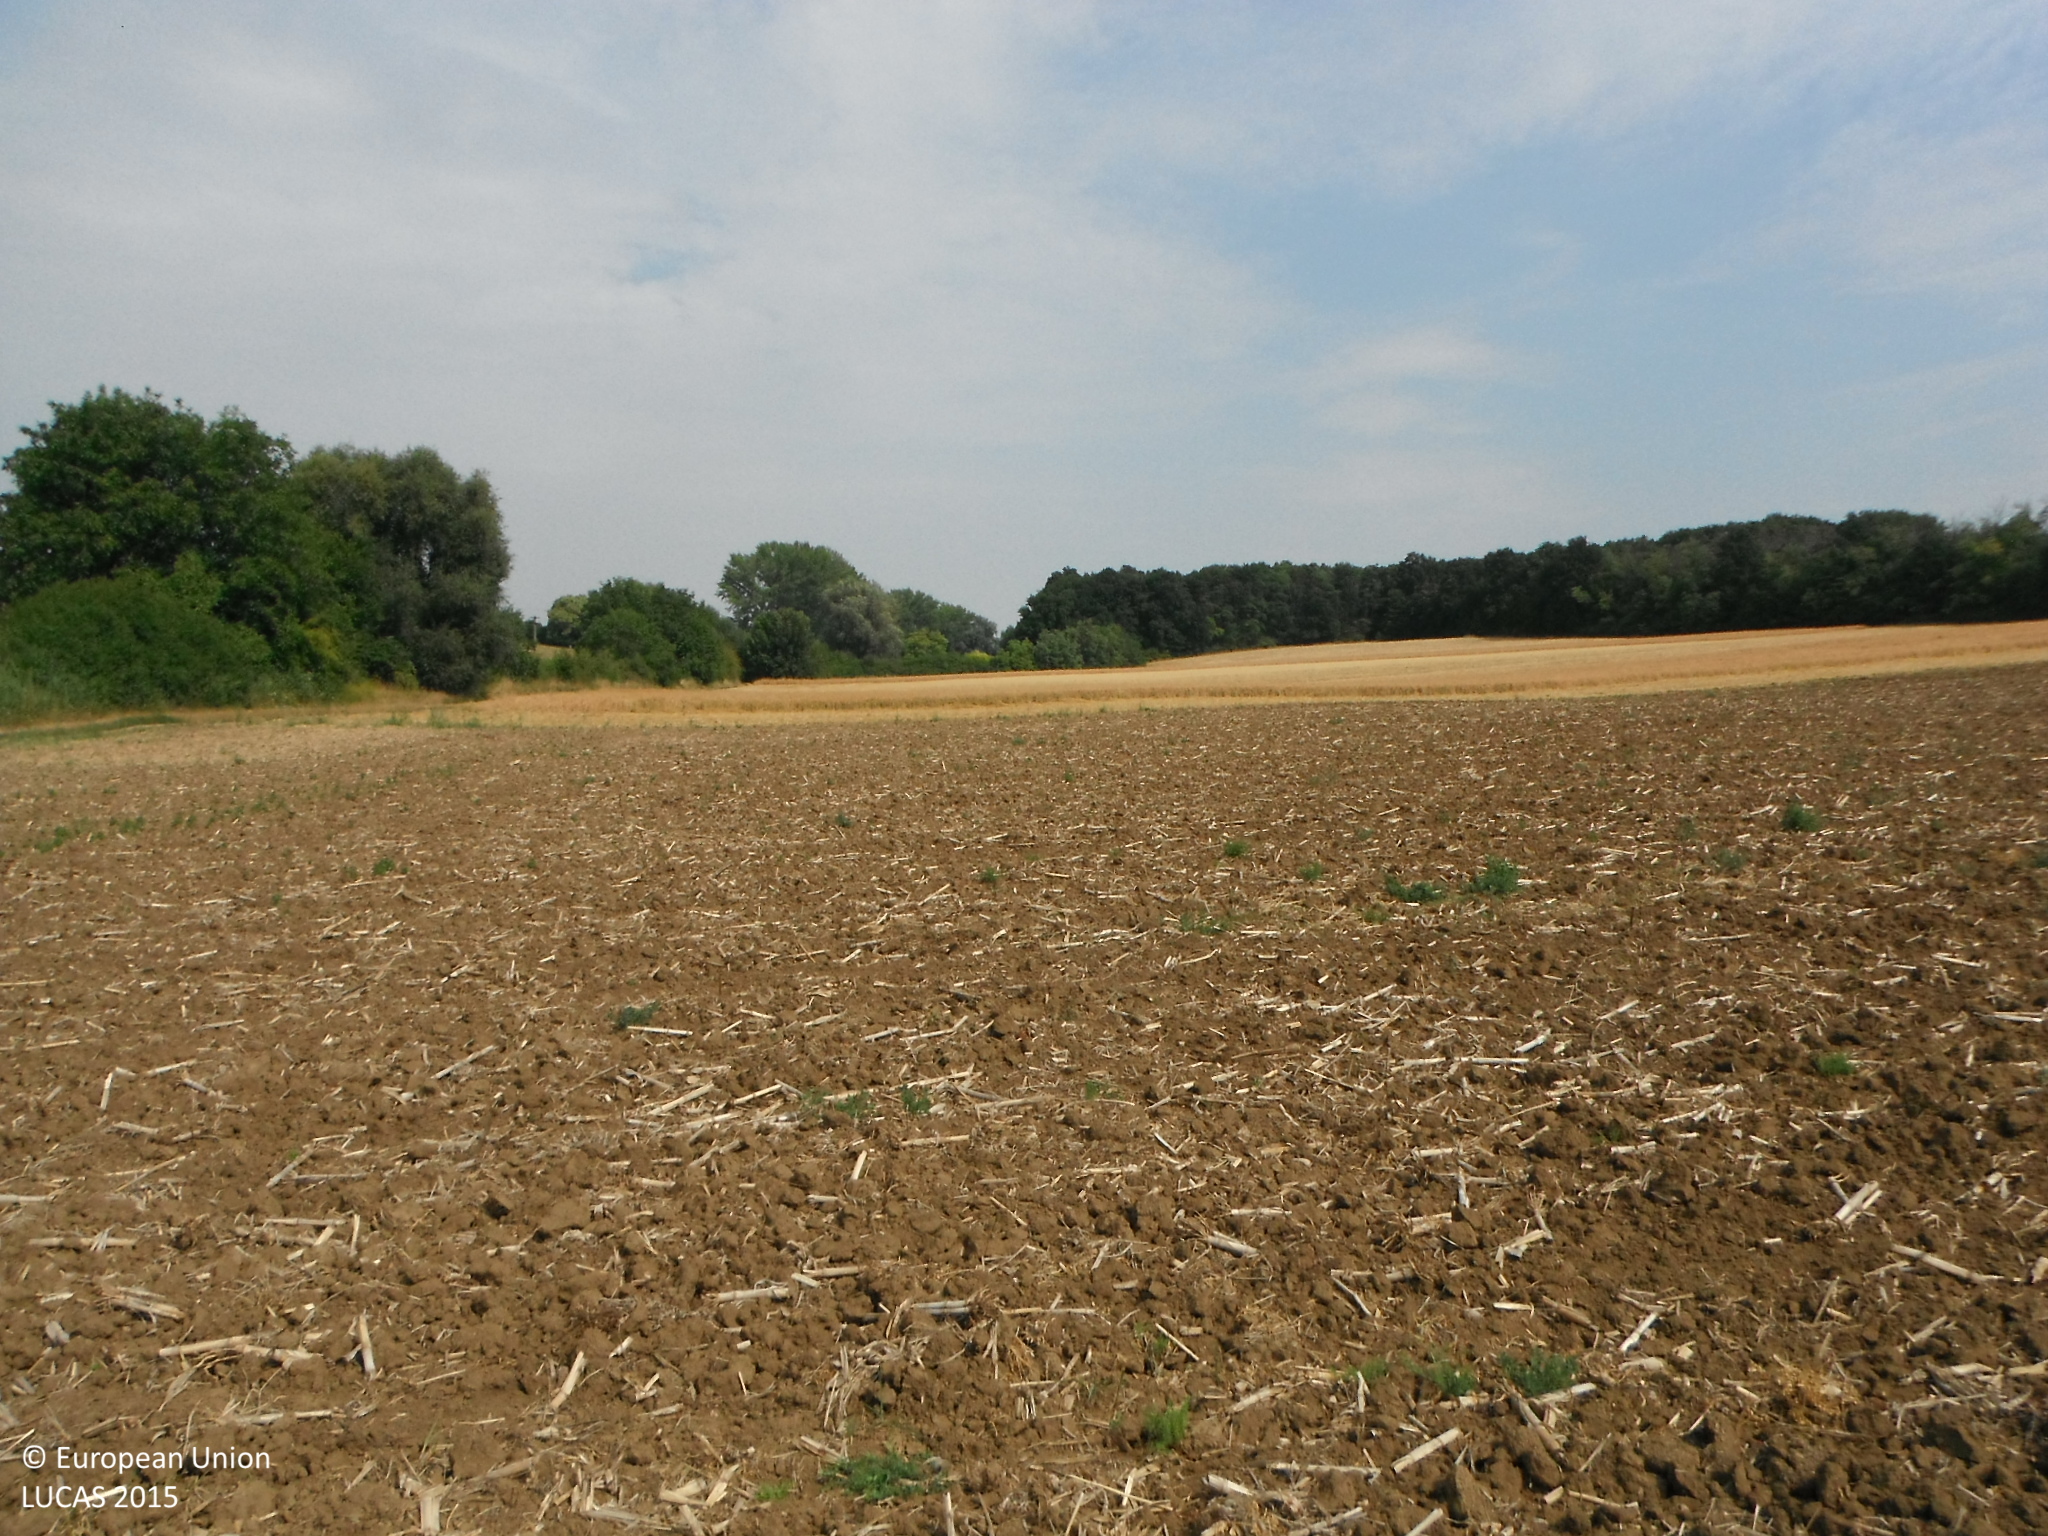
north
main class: Cropland
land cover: Maize
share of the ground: < 10 %
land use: Agriculture (excluding fallow land and kitchen gardens)
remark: Harvested field
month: August
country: SK
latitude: 48.2560
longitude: 18.0273
